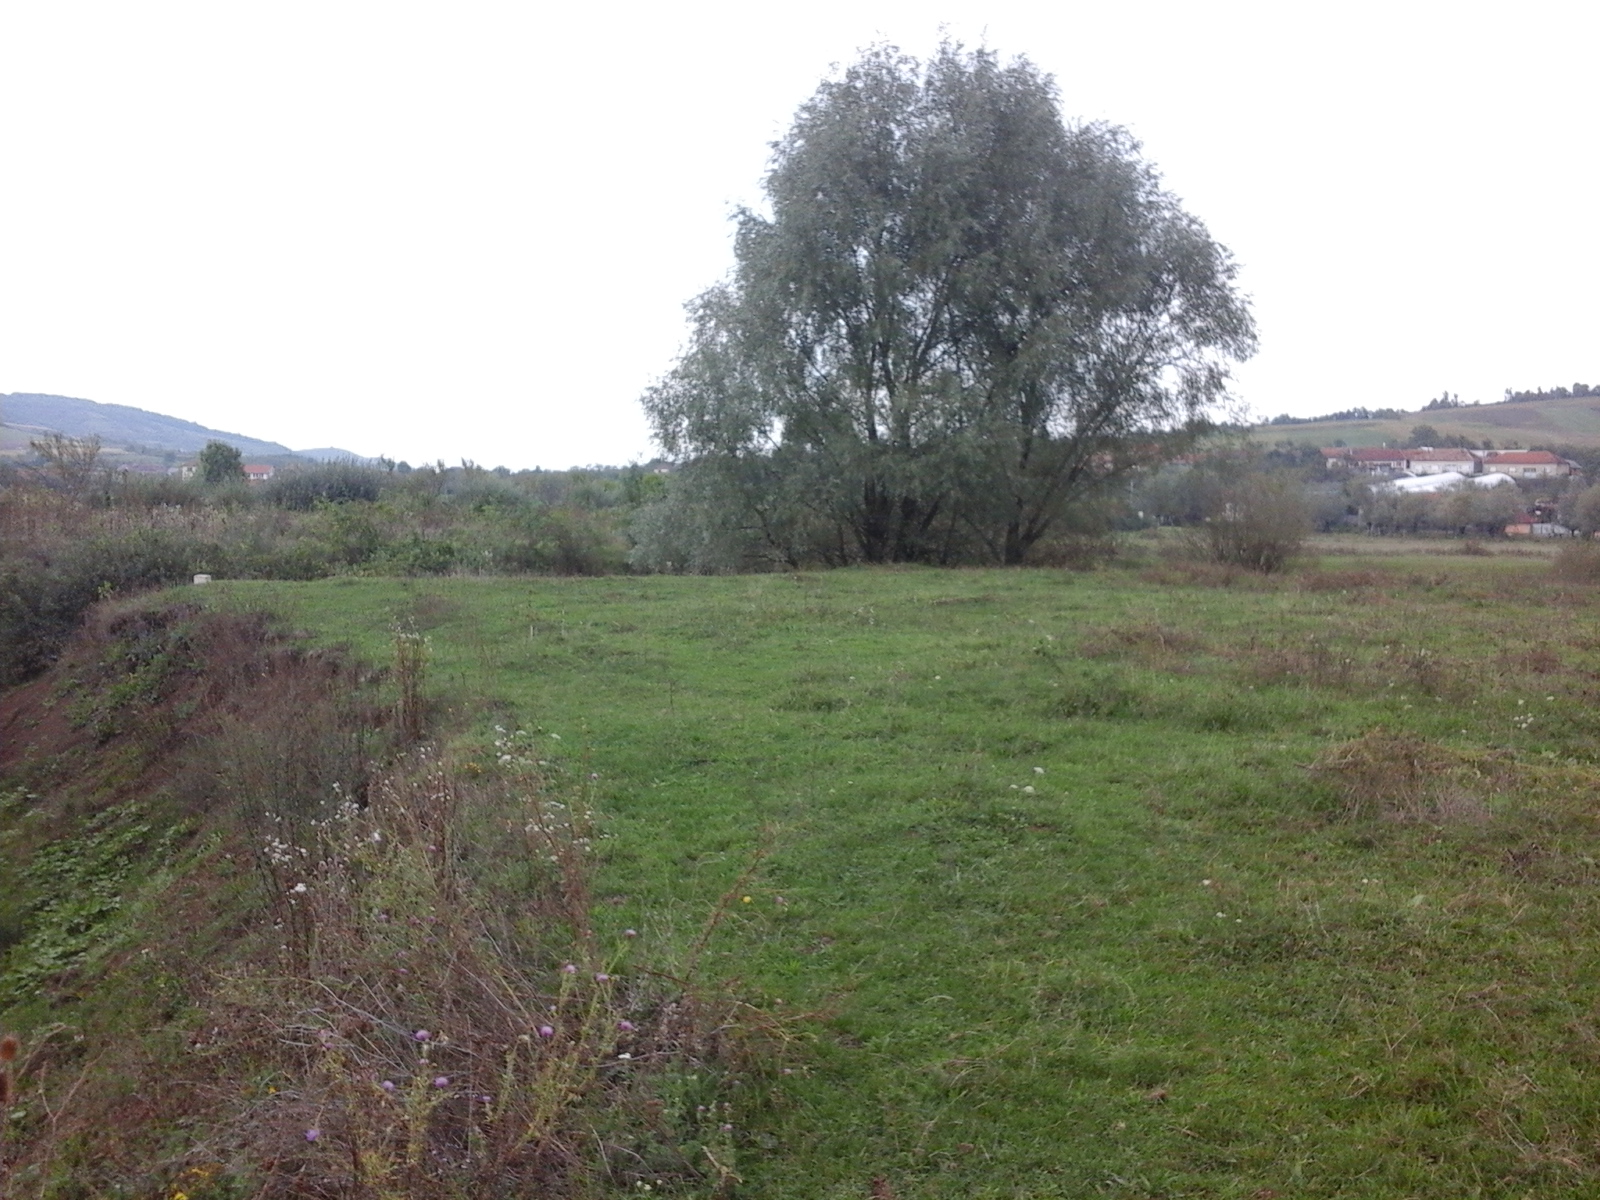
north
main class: Shrubland
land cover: Shrubland with sparse tree cover
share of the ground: > 75 %
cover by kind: shrubs 95 %, broadleaved forest trees 5 %
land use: Fallow land
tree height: < 5 m
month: September
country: RO
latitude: 46.7591
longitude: 22.2116
